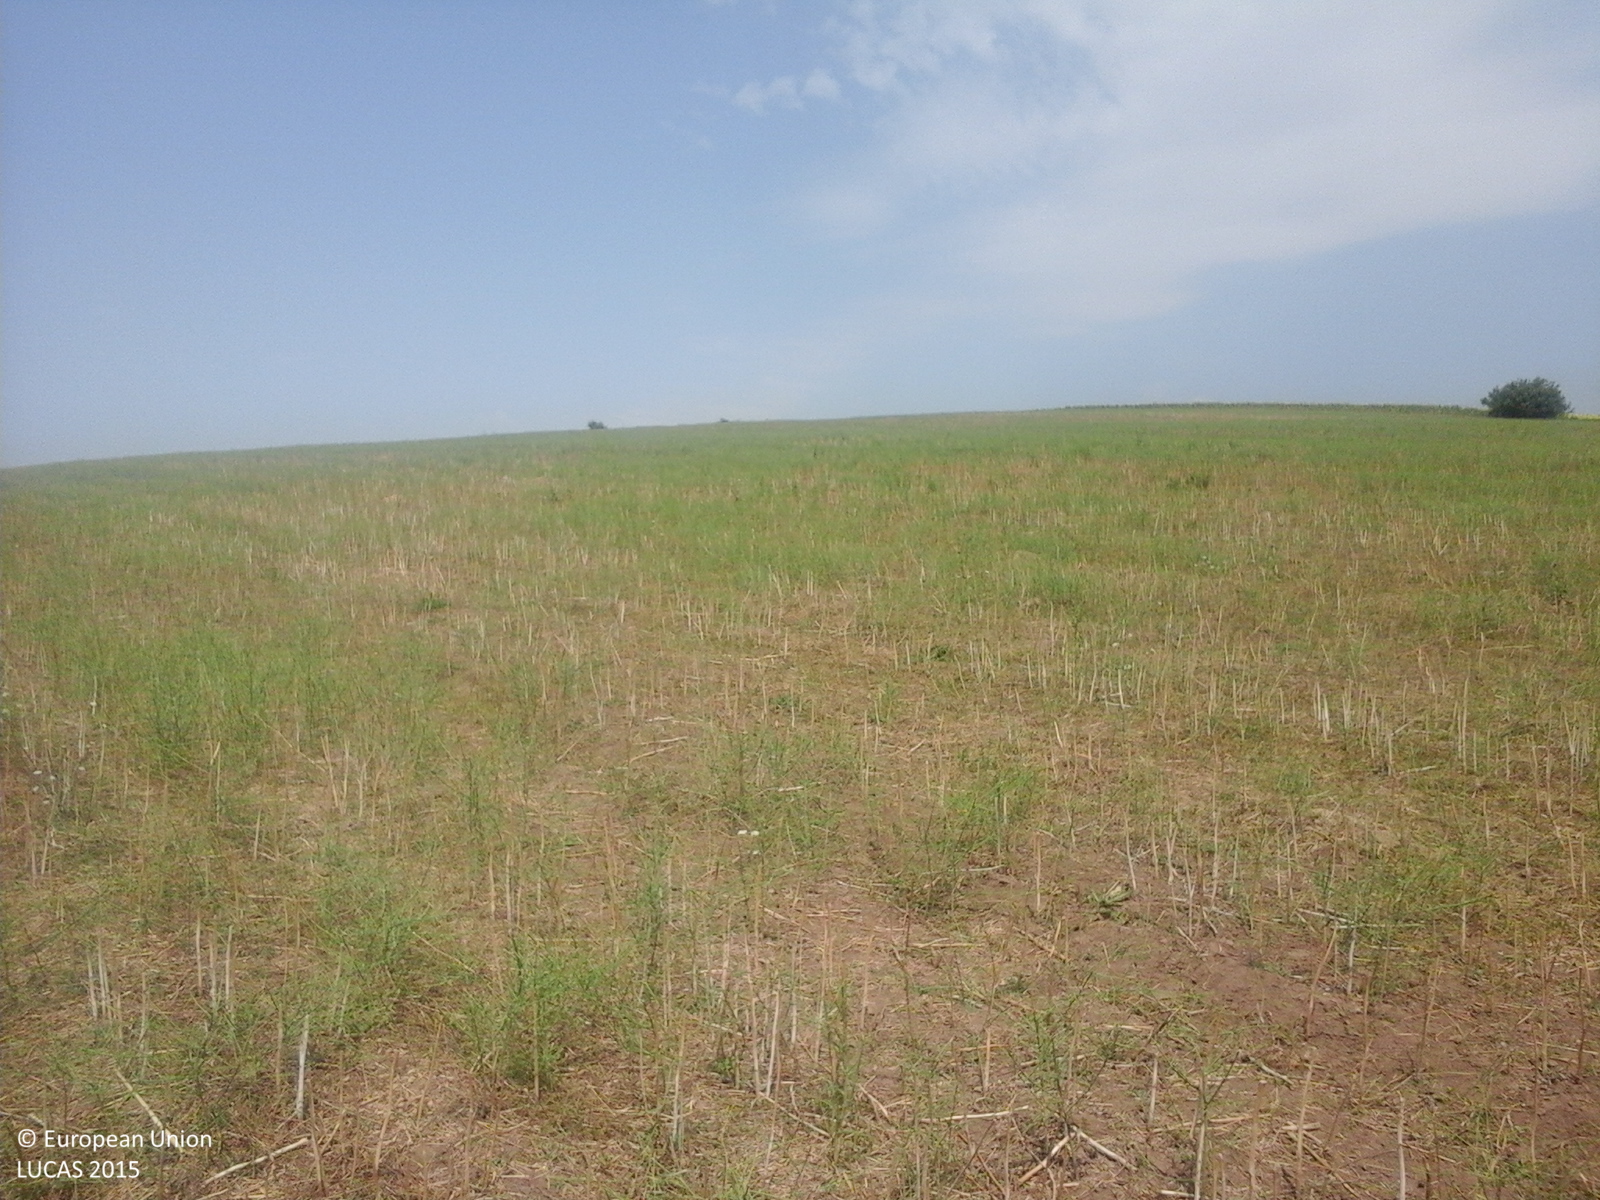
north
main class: Cropland
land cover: Rape and turnip rape
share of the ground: 25 - 50 %
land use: Agriculture (excluding fallow land and kitchen gardens)
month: August
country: RO
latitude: 44.0401
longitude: 27.8561
